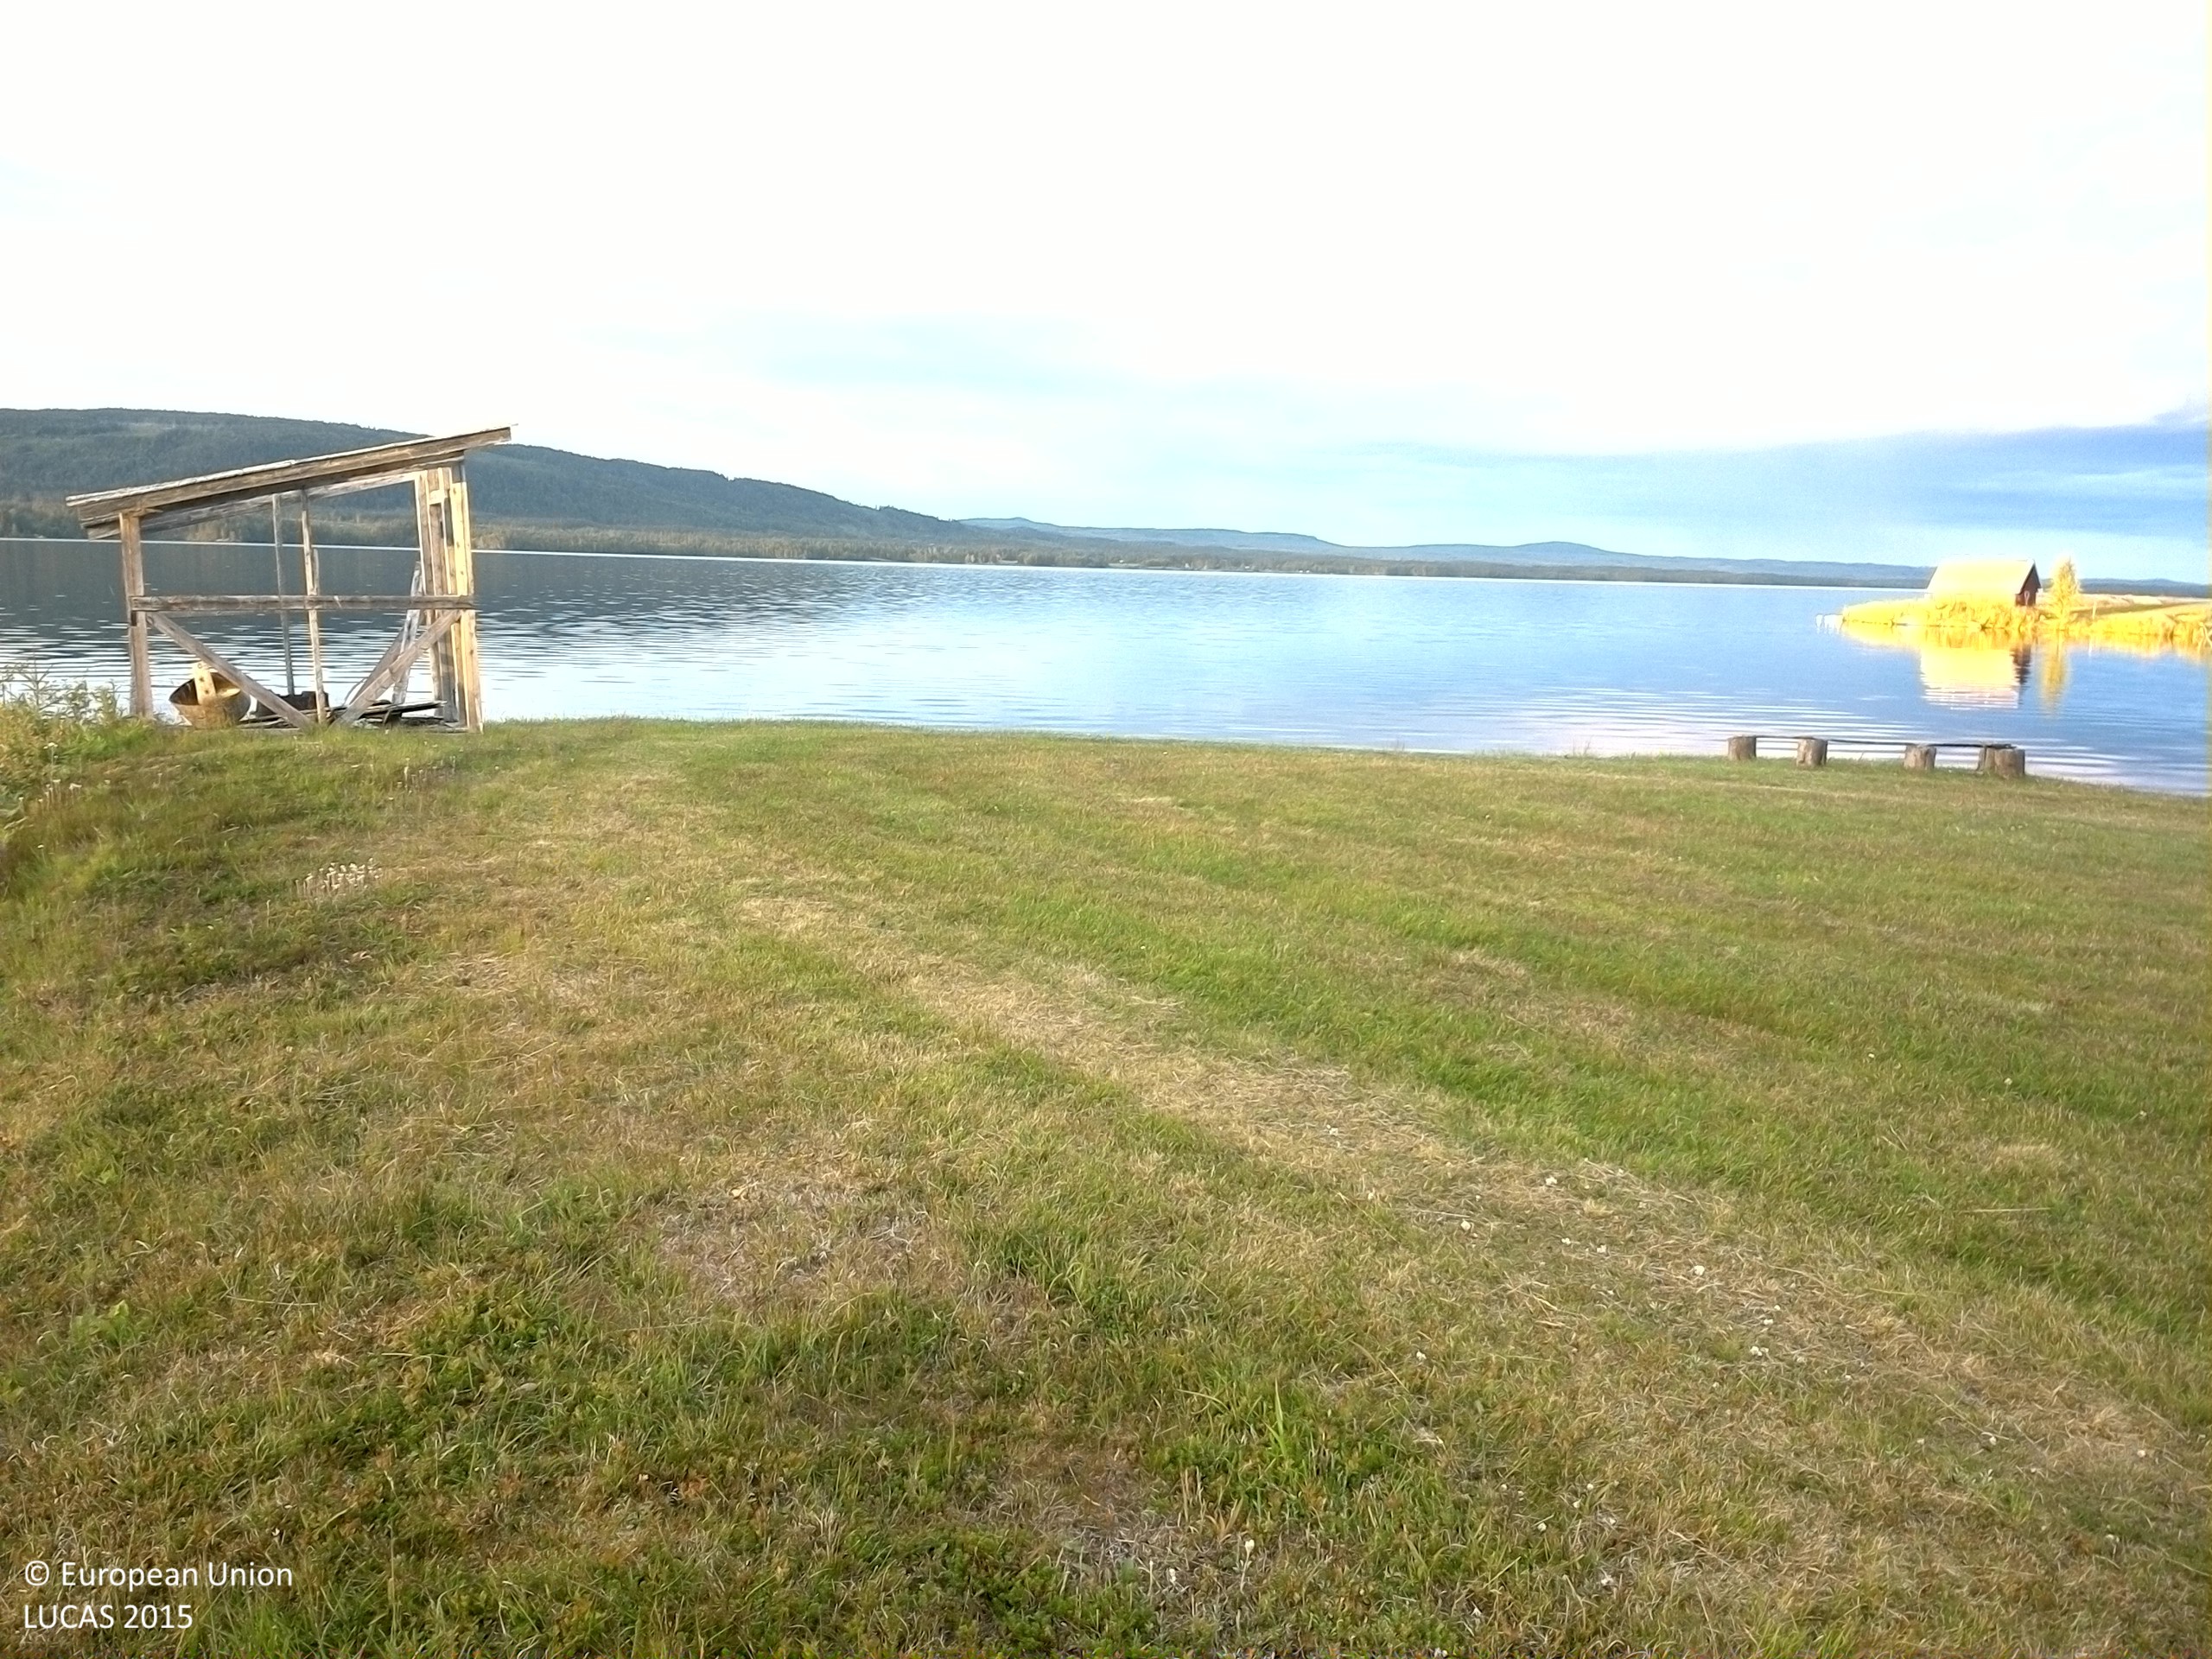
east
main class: Grassland
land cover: Grassland without tree/shrub cover
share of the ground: > 75 %
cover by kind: herbaceous plants 100 %
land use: Residential
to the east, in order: Grassland without tree/shrub cover; Inland fresh water bodies
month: July
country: SE
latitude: 64.3932
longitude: 16.0040
